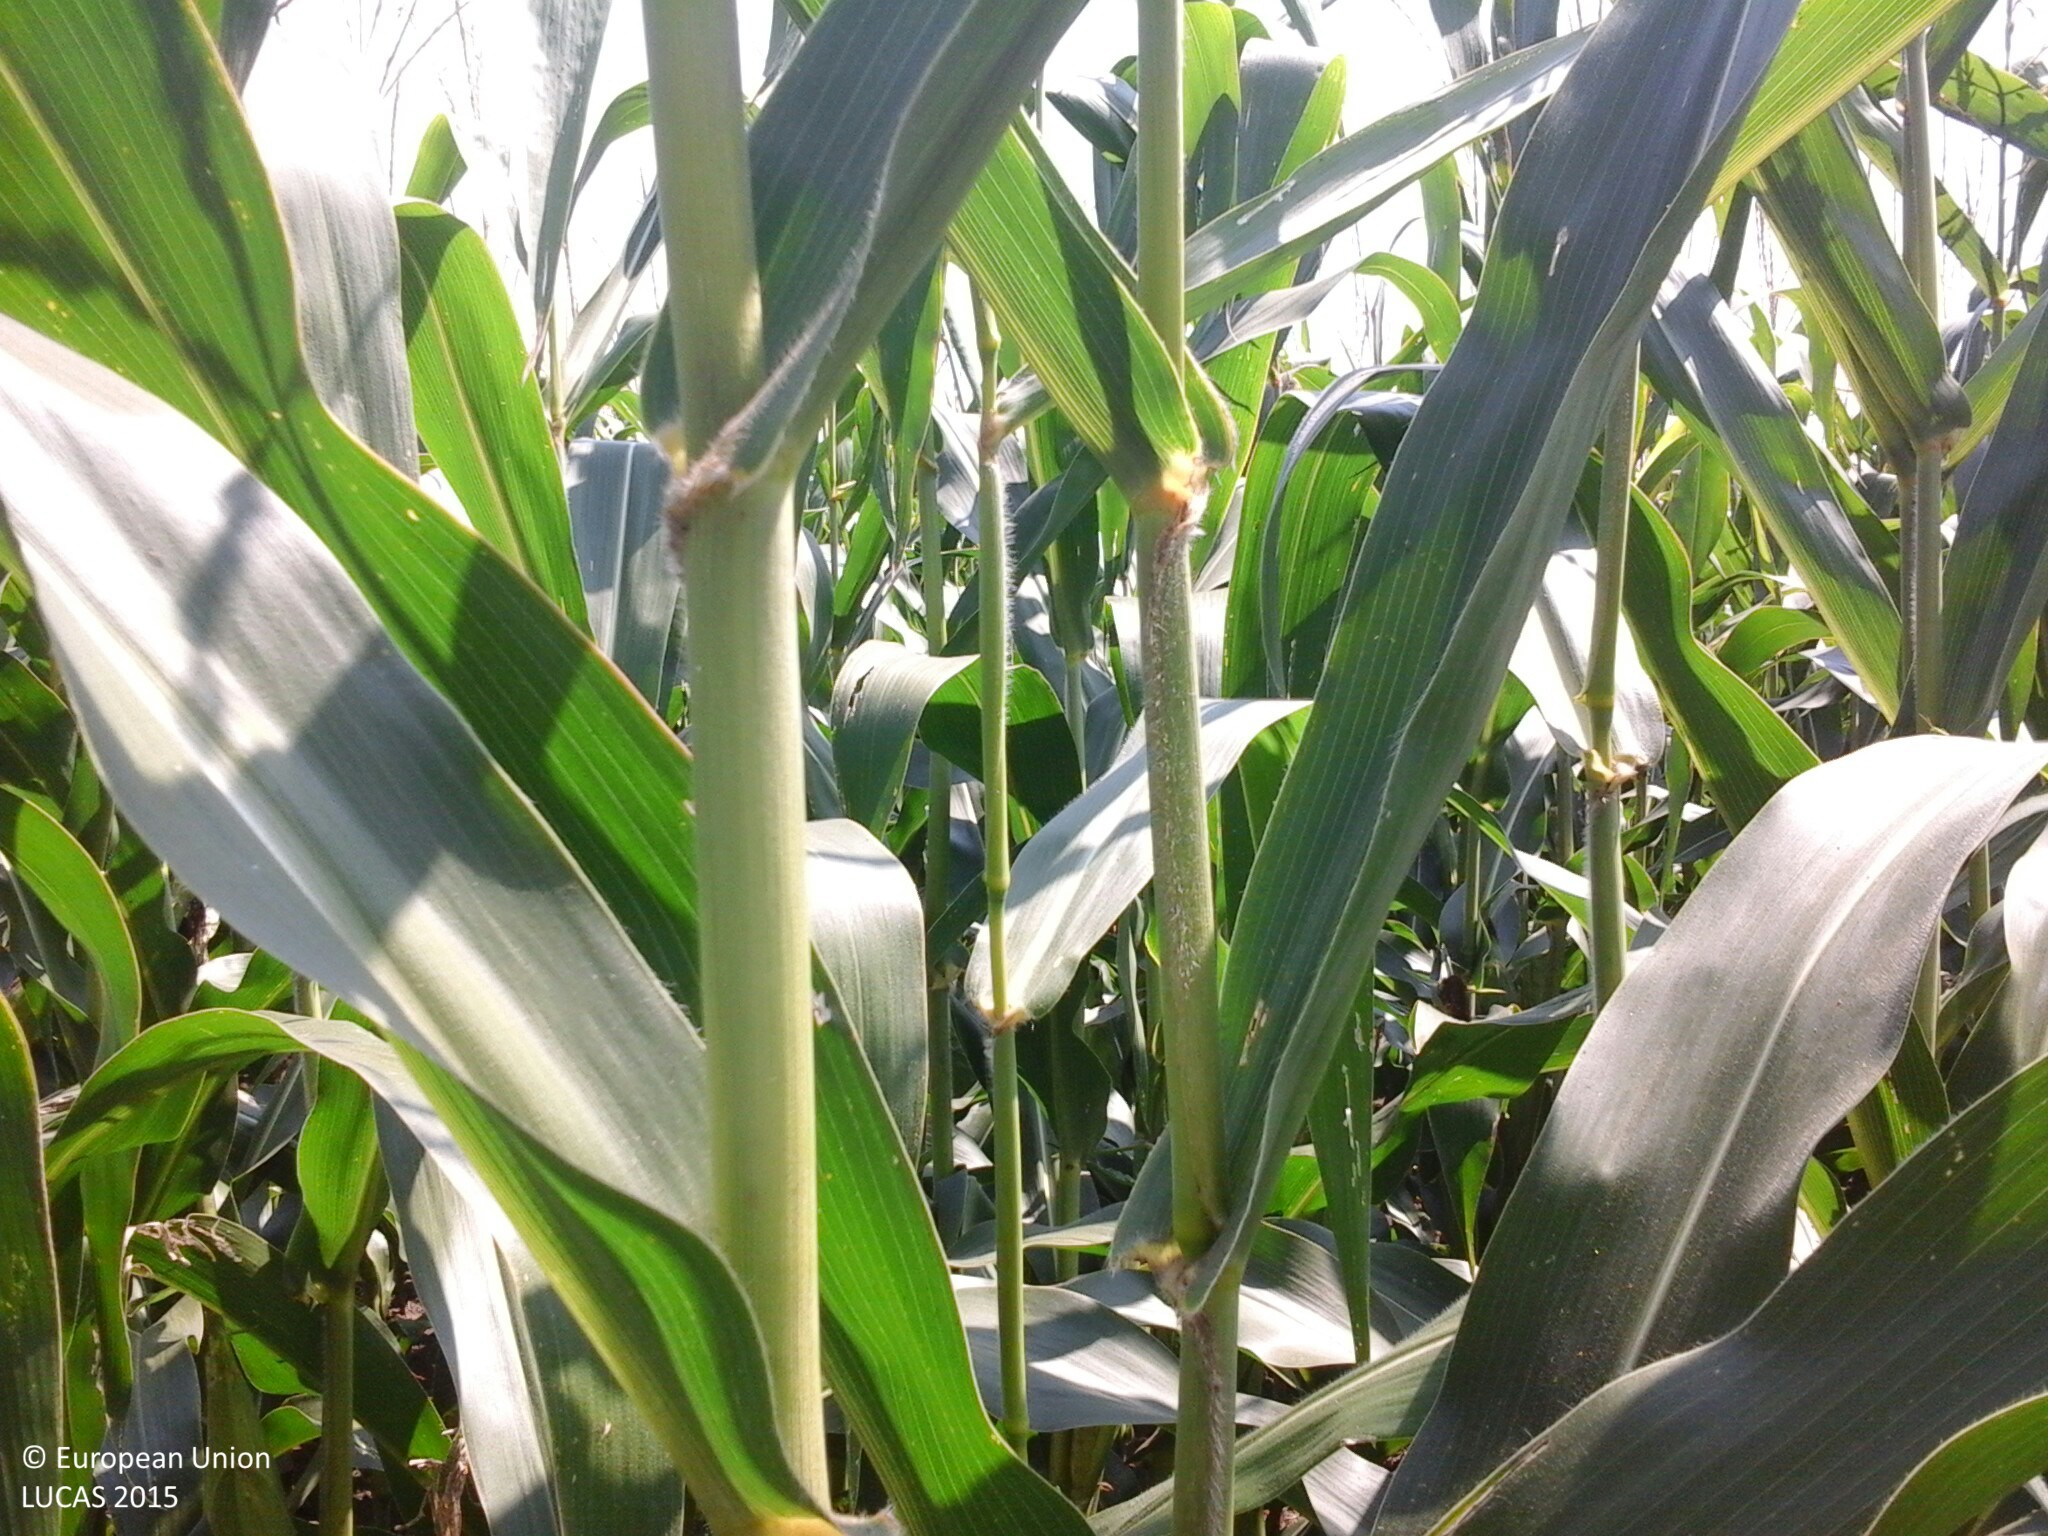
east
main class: Cropland
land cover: Maize
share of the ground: > 75 %
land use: Agriculture (excluding fallow land and kitchen gardens)
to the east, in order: Maize; Grass margins; Tracks; Grass margins; Maize
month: August
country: HU
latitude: 46.9114
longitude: 18.3481
